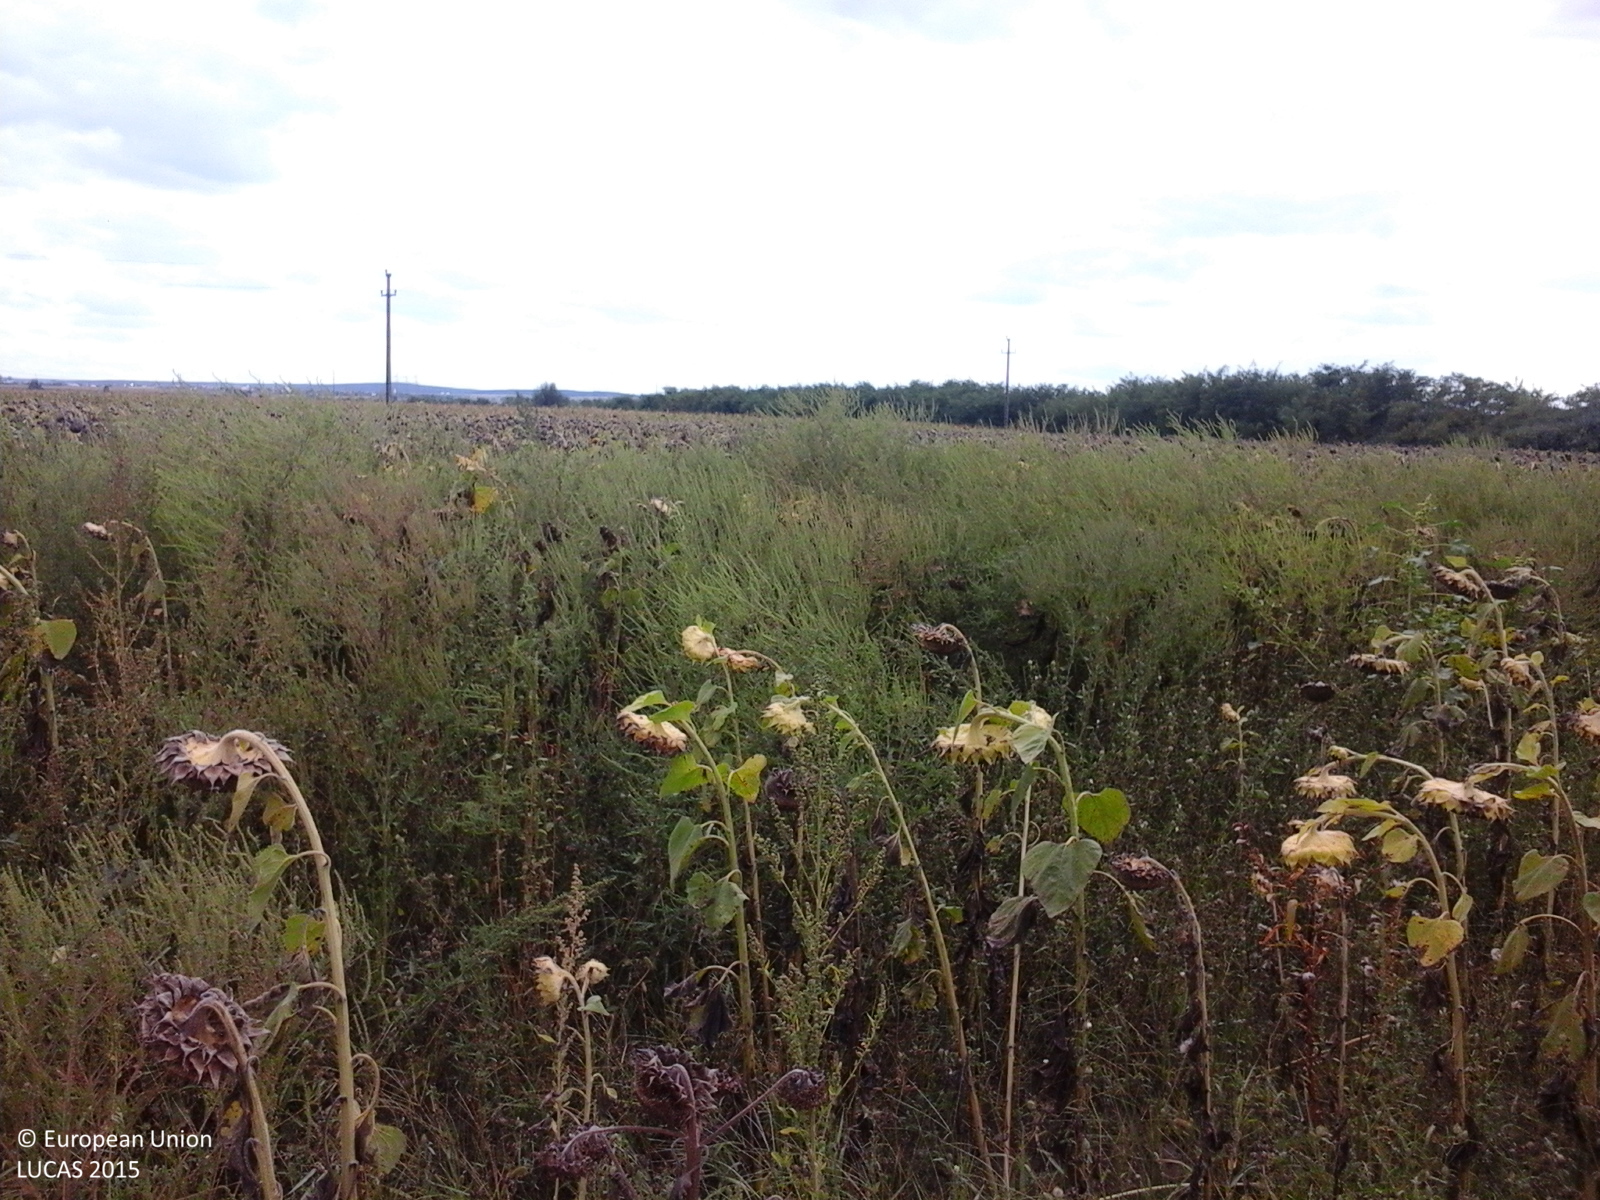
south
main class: Cropland
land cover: Sunflower
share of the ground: 50 - 75 %
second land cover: Spontaneously vegetated surfaces
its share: 25 - 50 %
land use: Agriculture (excluding fallow land and kitchen gardens)
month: September
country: RO
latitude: 47.5145
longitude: 22.6073
